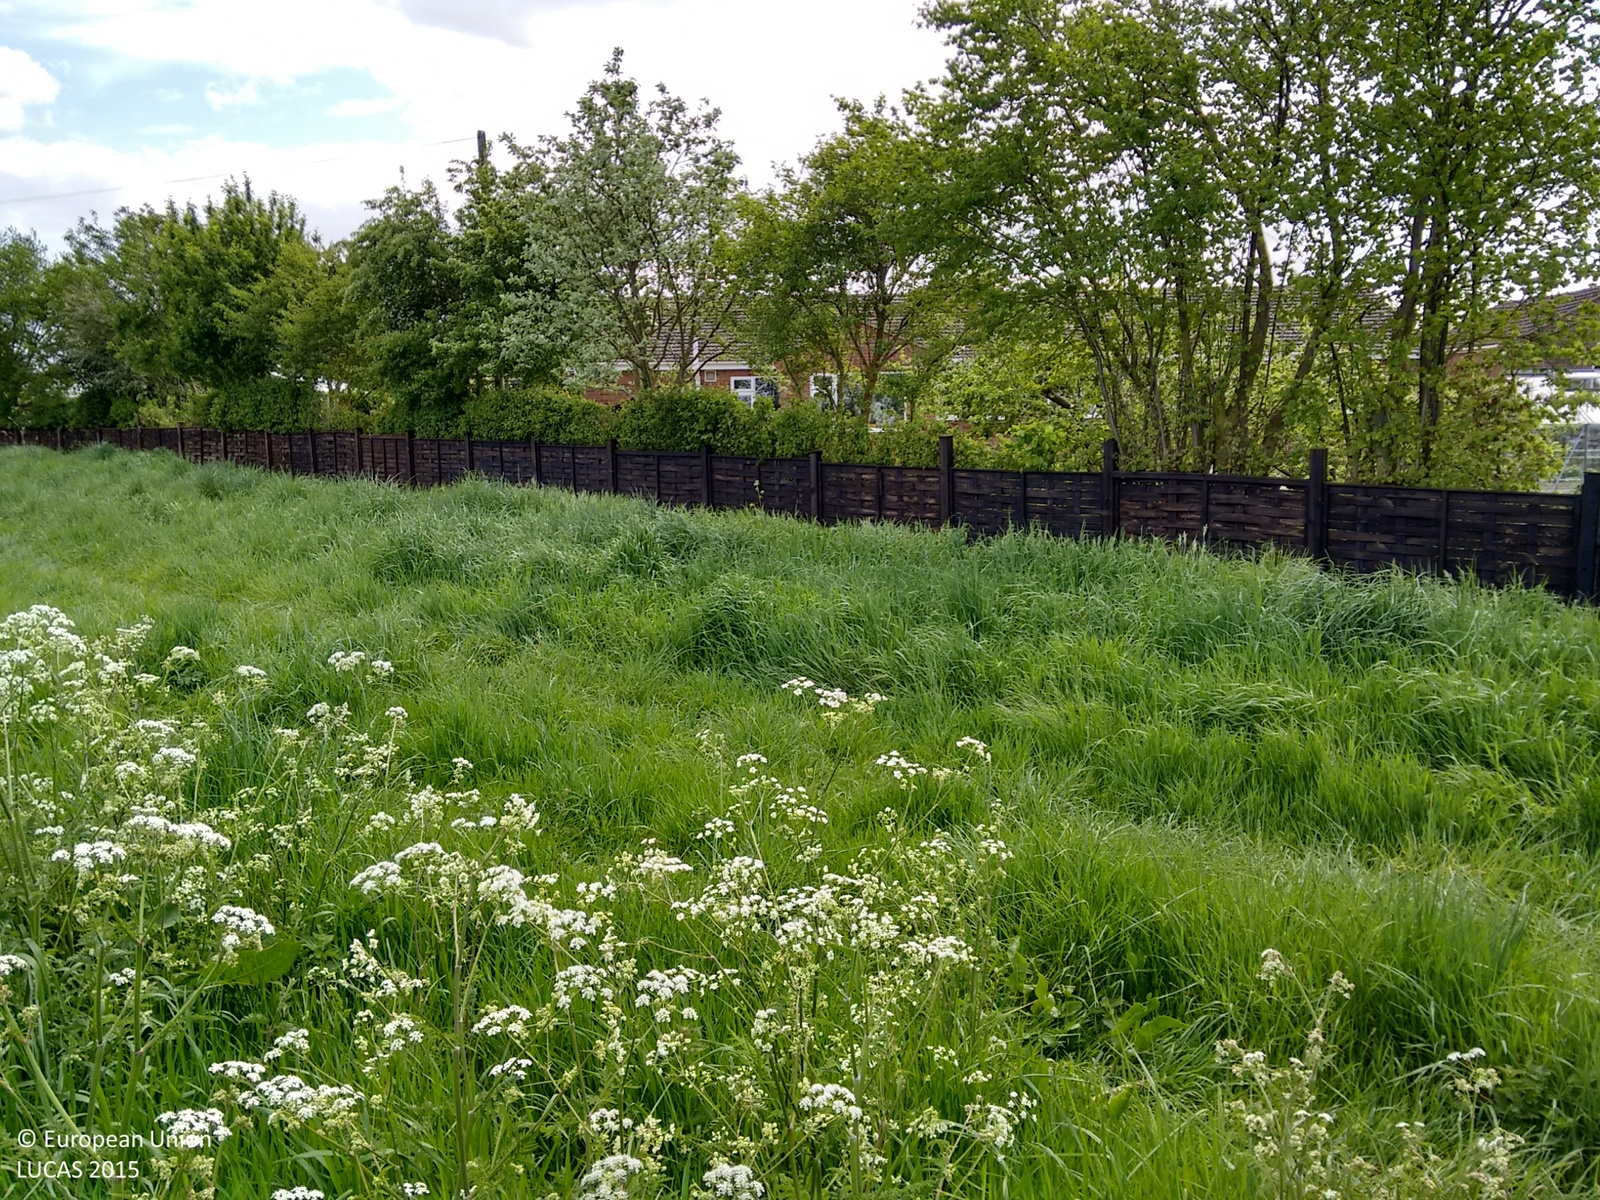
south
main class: Grassland
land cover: Grassland without tree/shrub cover
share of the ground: > 75 %
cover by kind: herbaceous plants 100 %
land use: Agriculture (excluding fallow land and kitchen gardens)
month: May
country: GB
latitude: 52.9442
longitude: -0.0780
